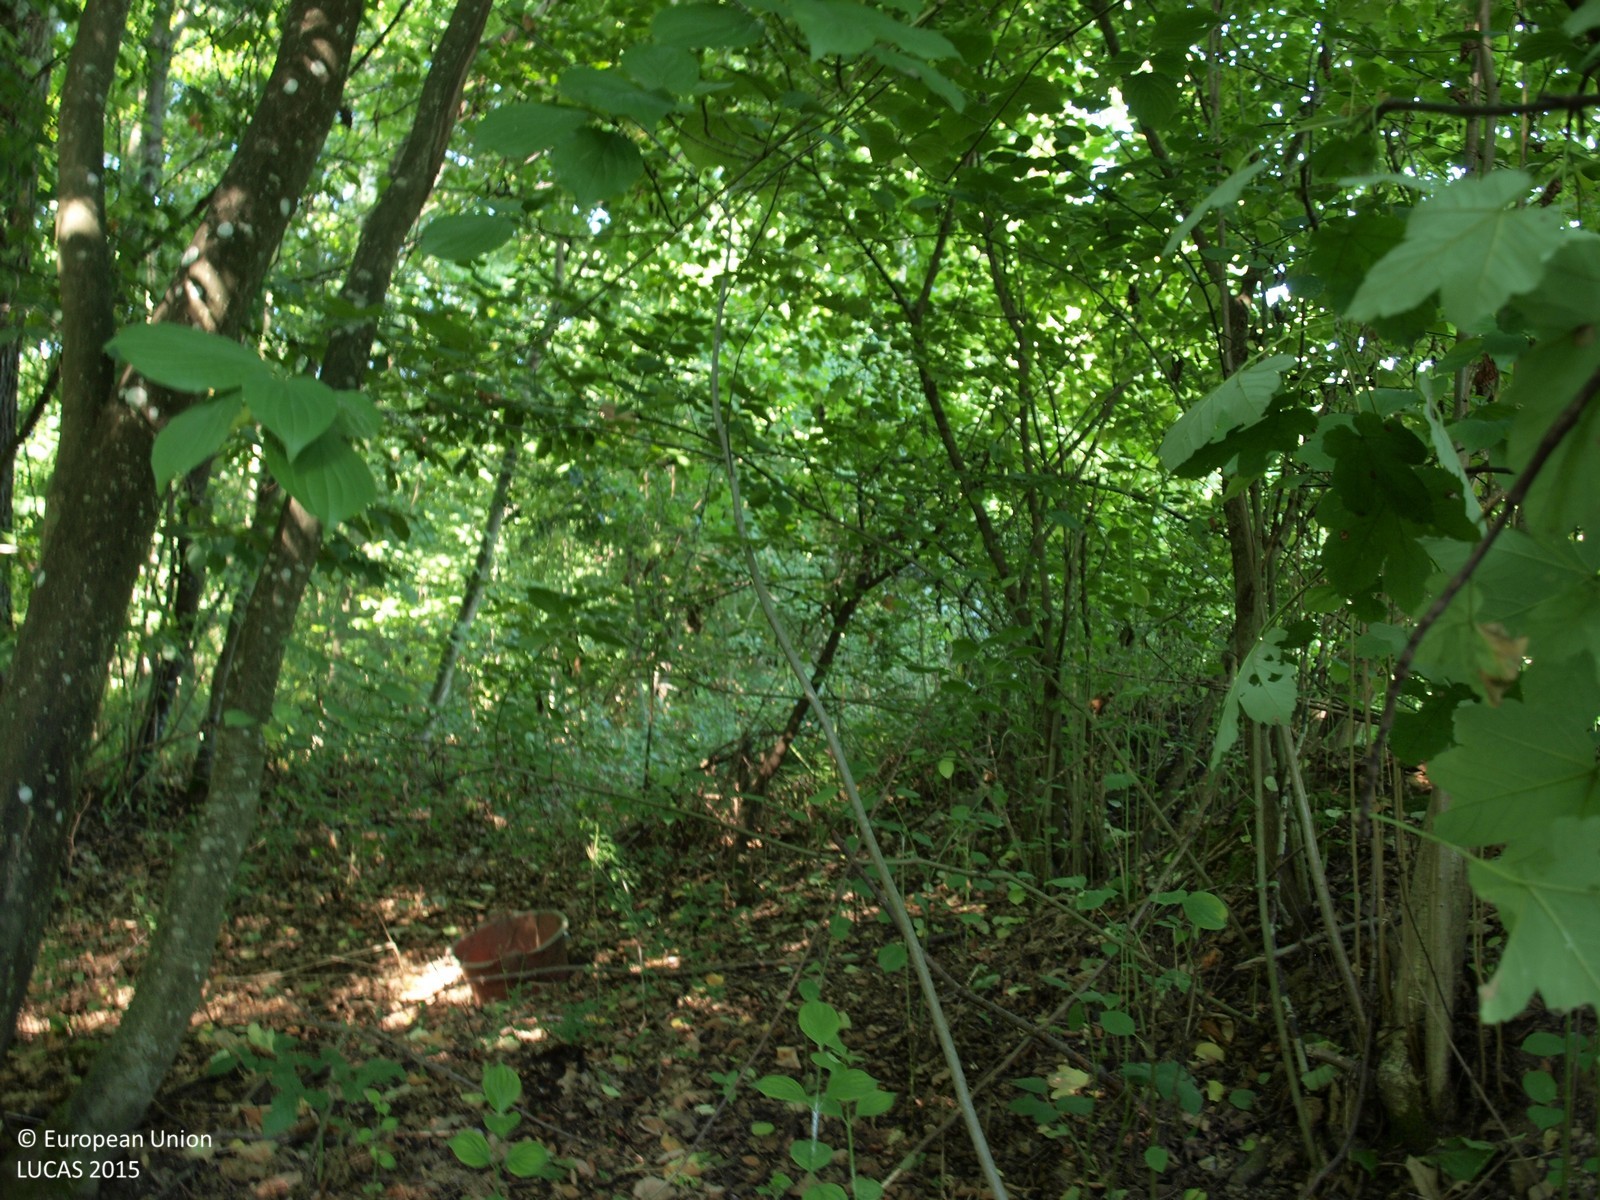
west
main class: Woodland
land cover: Broadleaved woodland
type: mesophytic deciduous forest
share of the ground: > 75 %
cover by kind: broadleaved forest trees 100 %
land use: Forestry
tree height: > 5 m
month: August
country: HR
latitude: 45.8780
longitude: 16.2733
